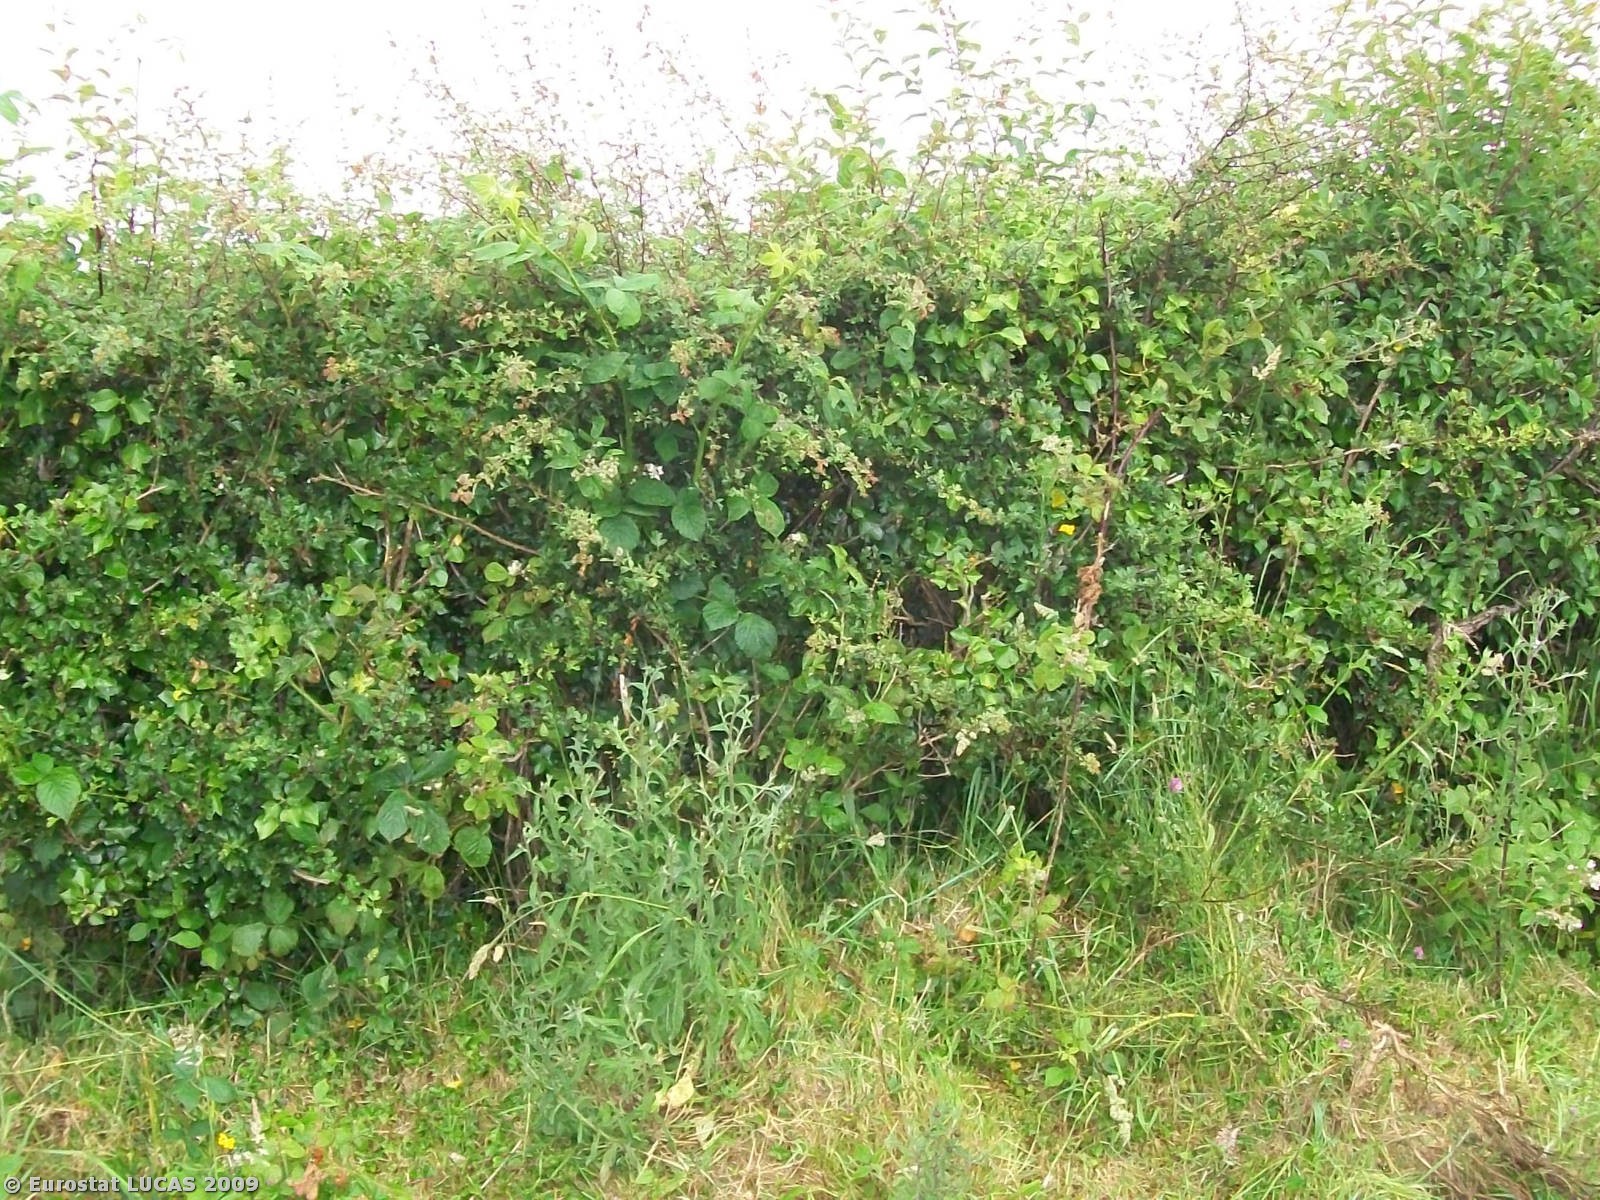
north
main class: Grassland
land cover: Grassland without tree/shrub cover
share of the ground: > 75 %
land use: Agriculture (excluding fallow land and kitchen gardens)
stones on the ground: < 10 %
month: June
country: GB
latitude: 54.4916
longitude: -7.3649
